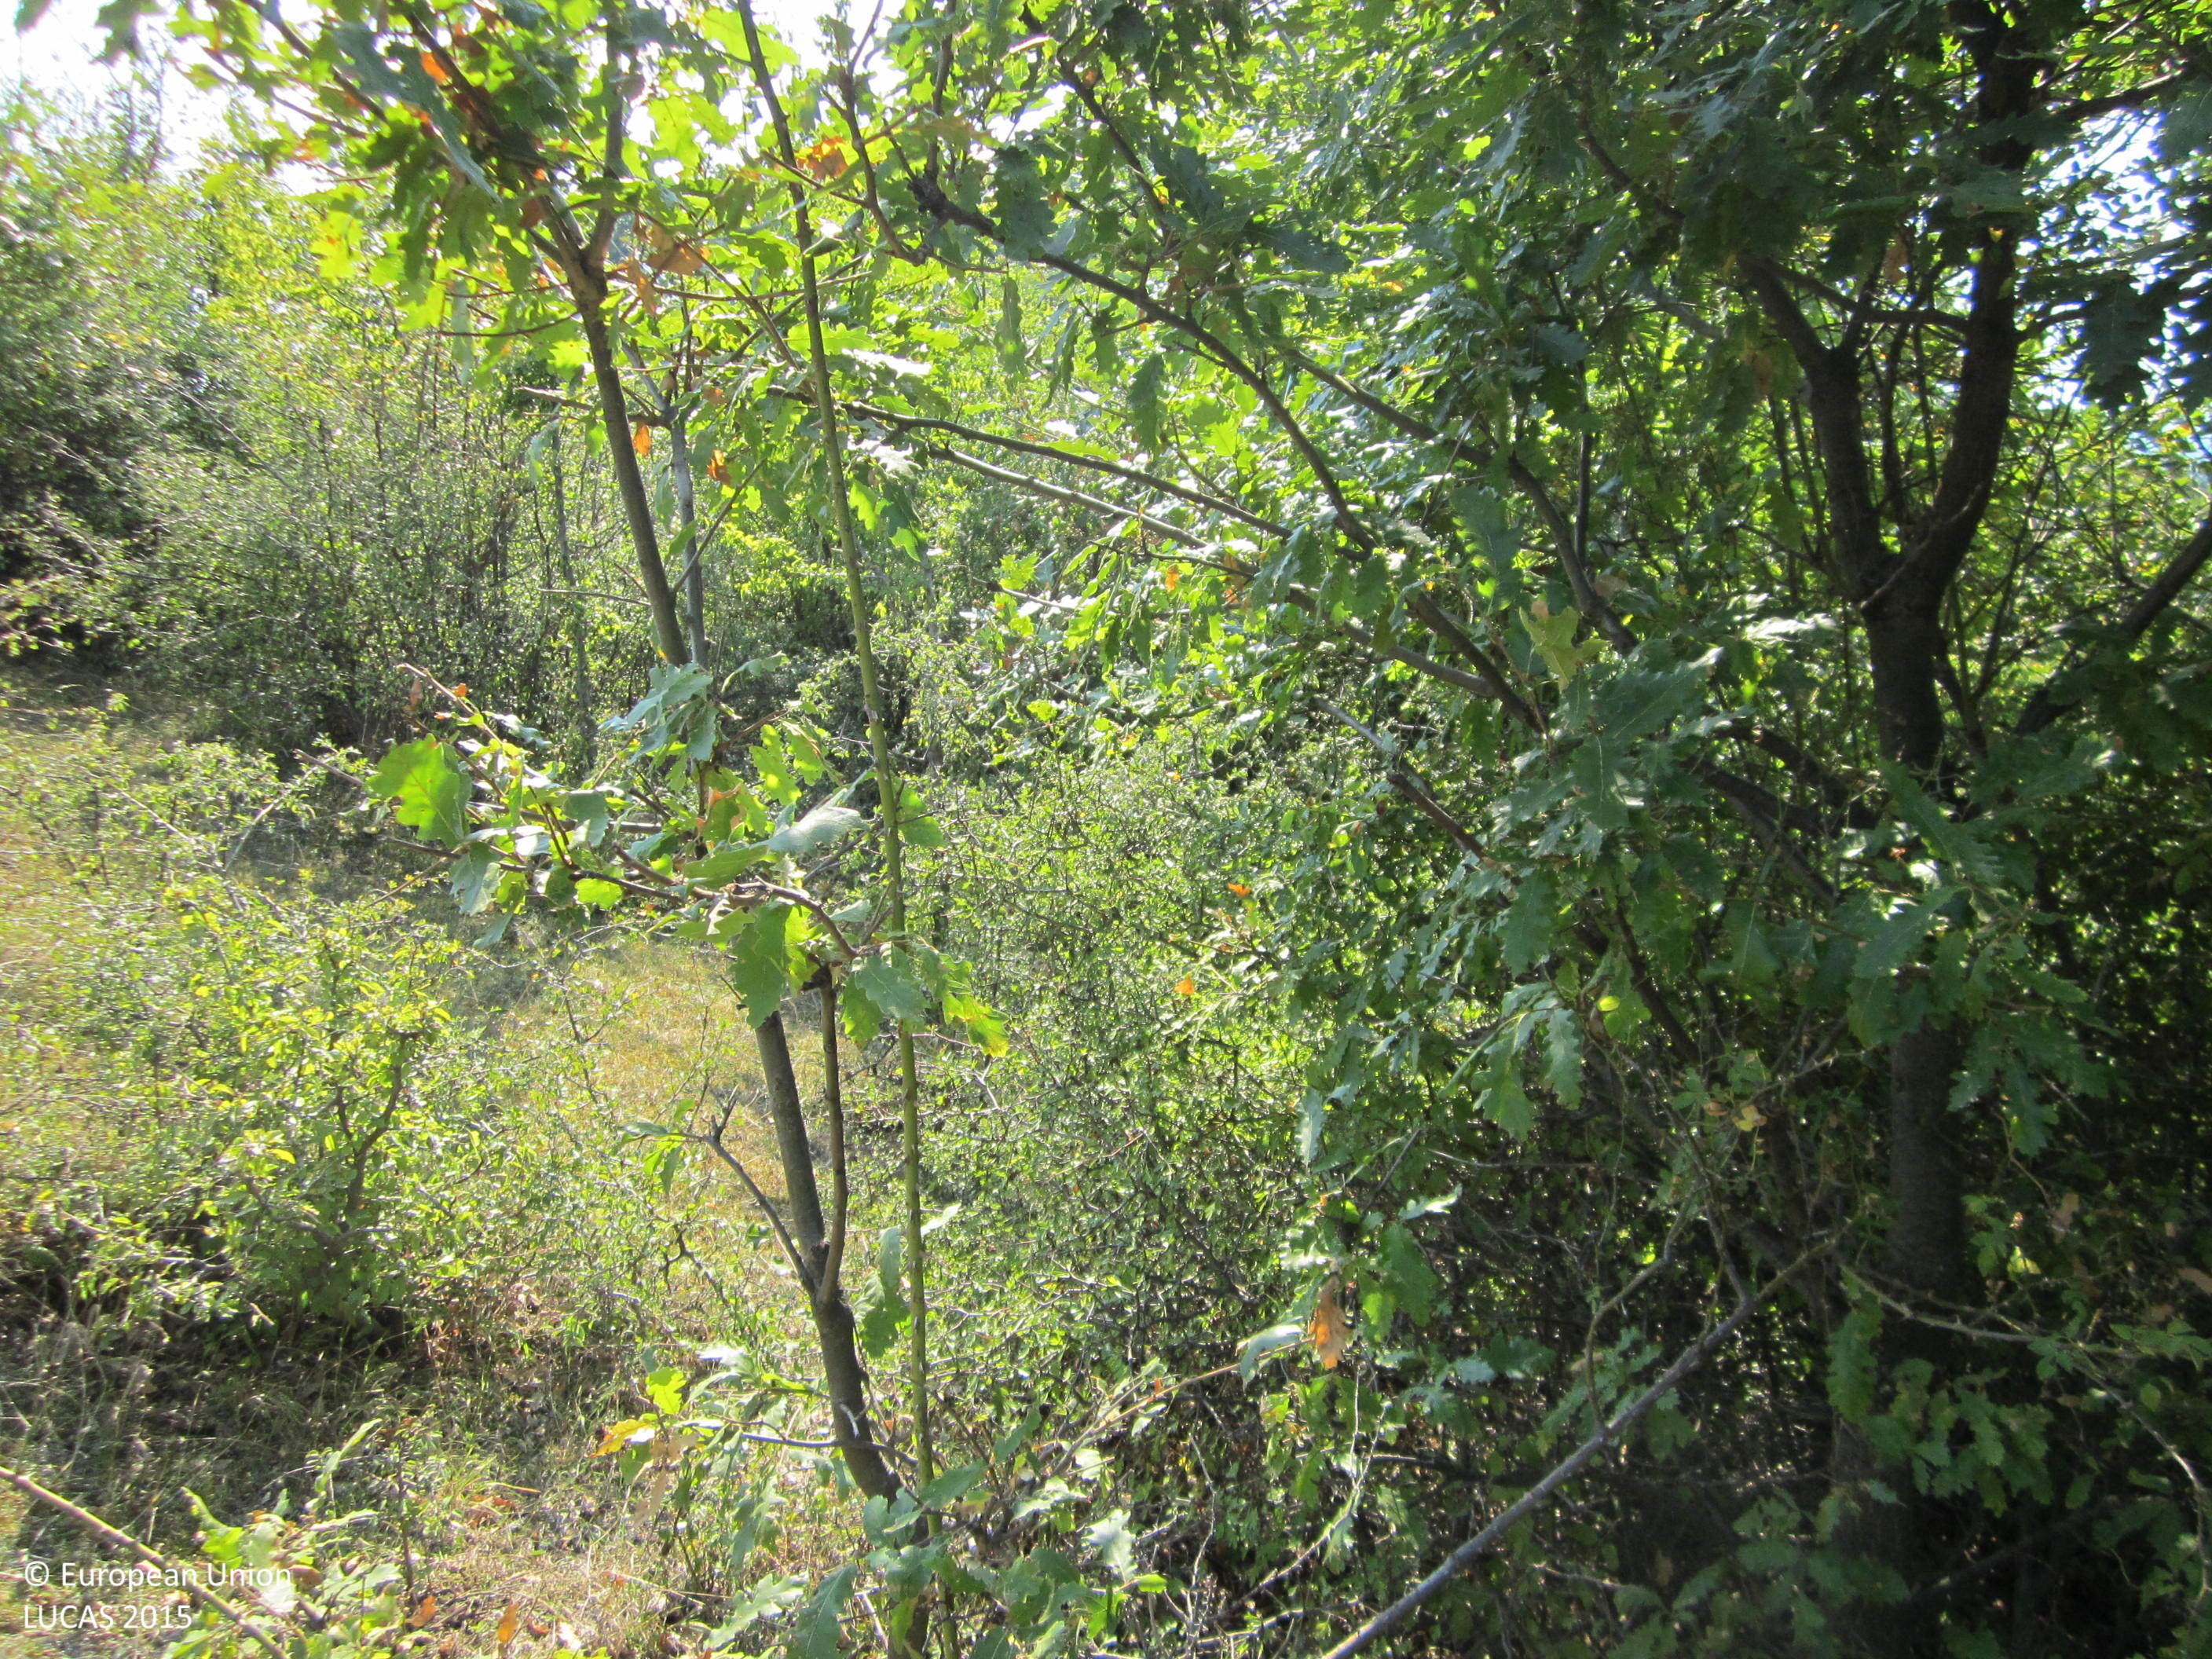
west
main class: Woodland
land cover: Broadleaved woodland
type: mesophytic deciduous forest
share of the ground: > 75 %
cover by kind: broadleaved forest trees 85 %, herbaceous plants 15 %
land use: Forestry
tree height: > 5 m
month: September
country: BG
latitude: 42.9310
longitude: 27.1332
